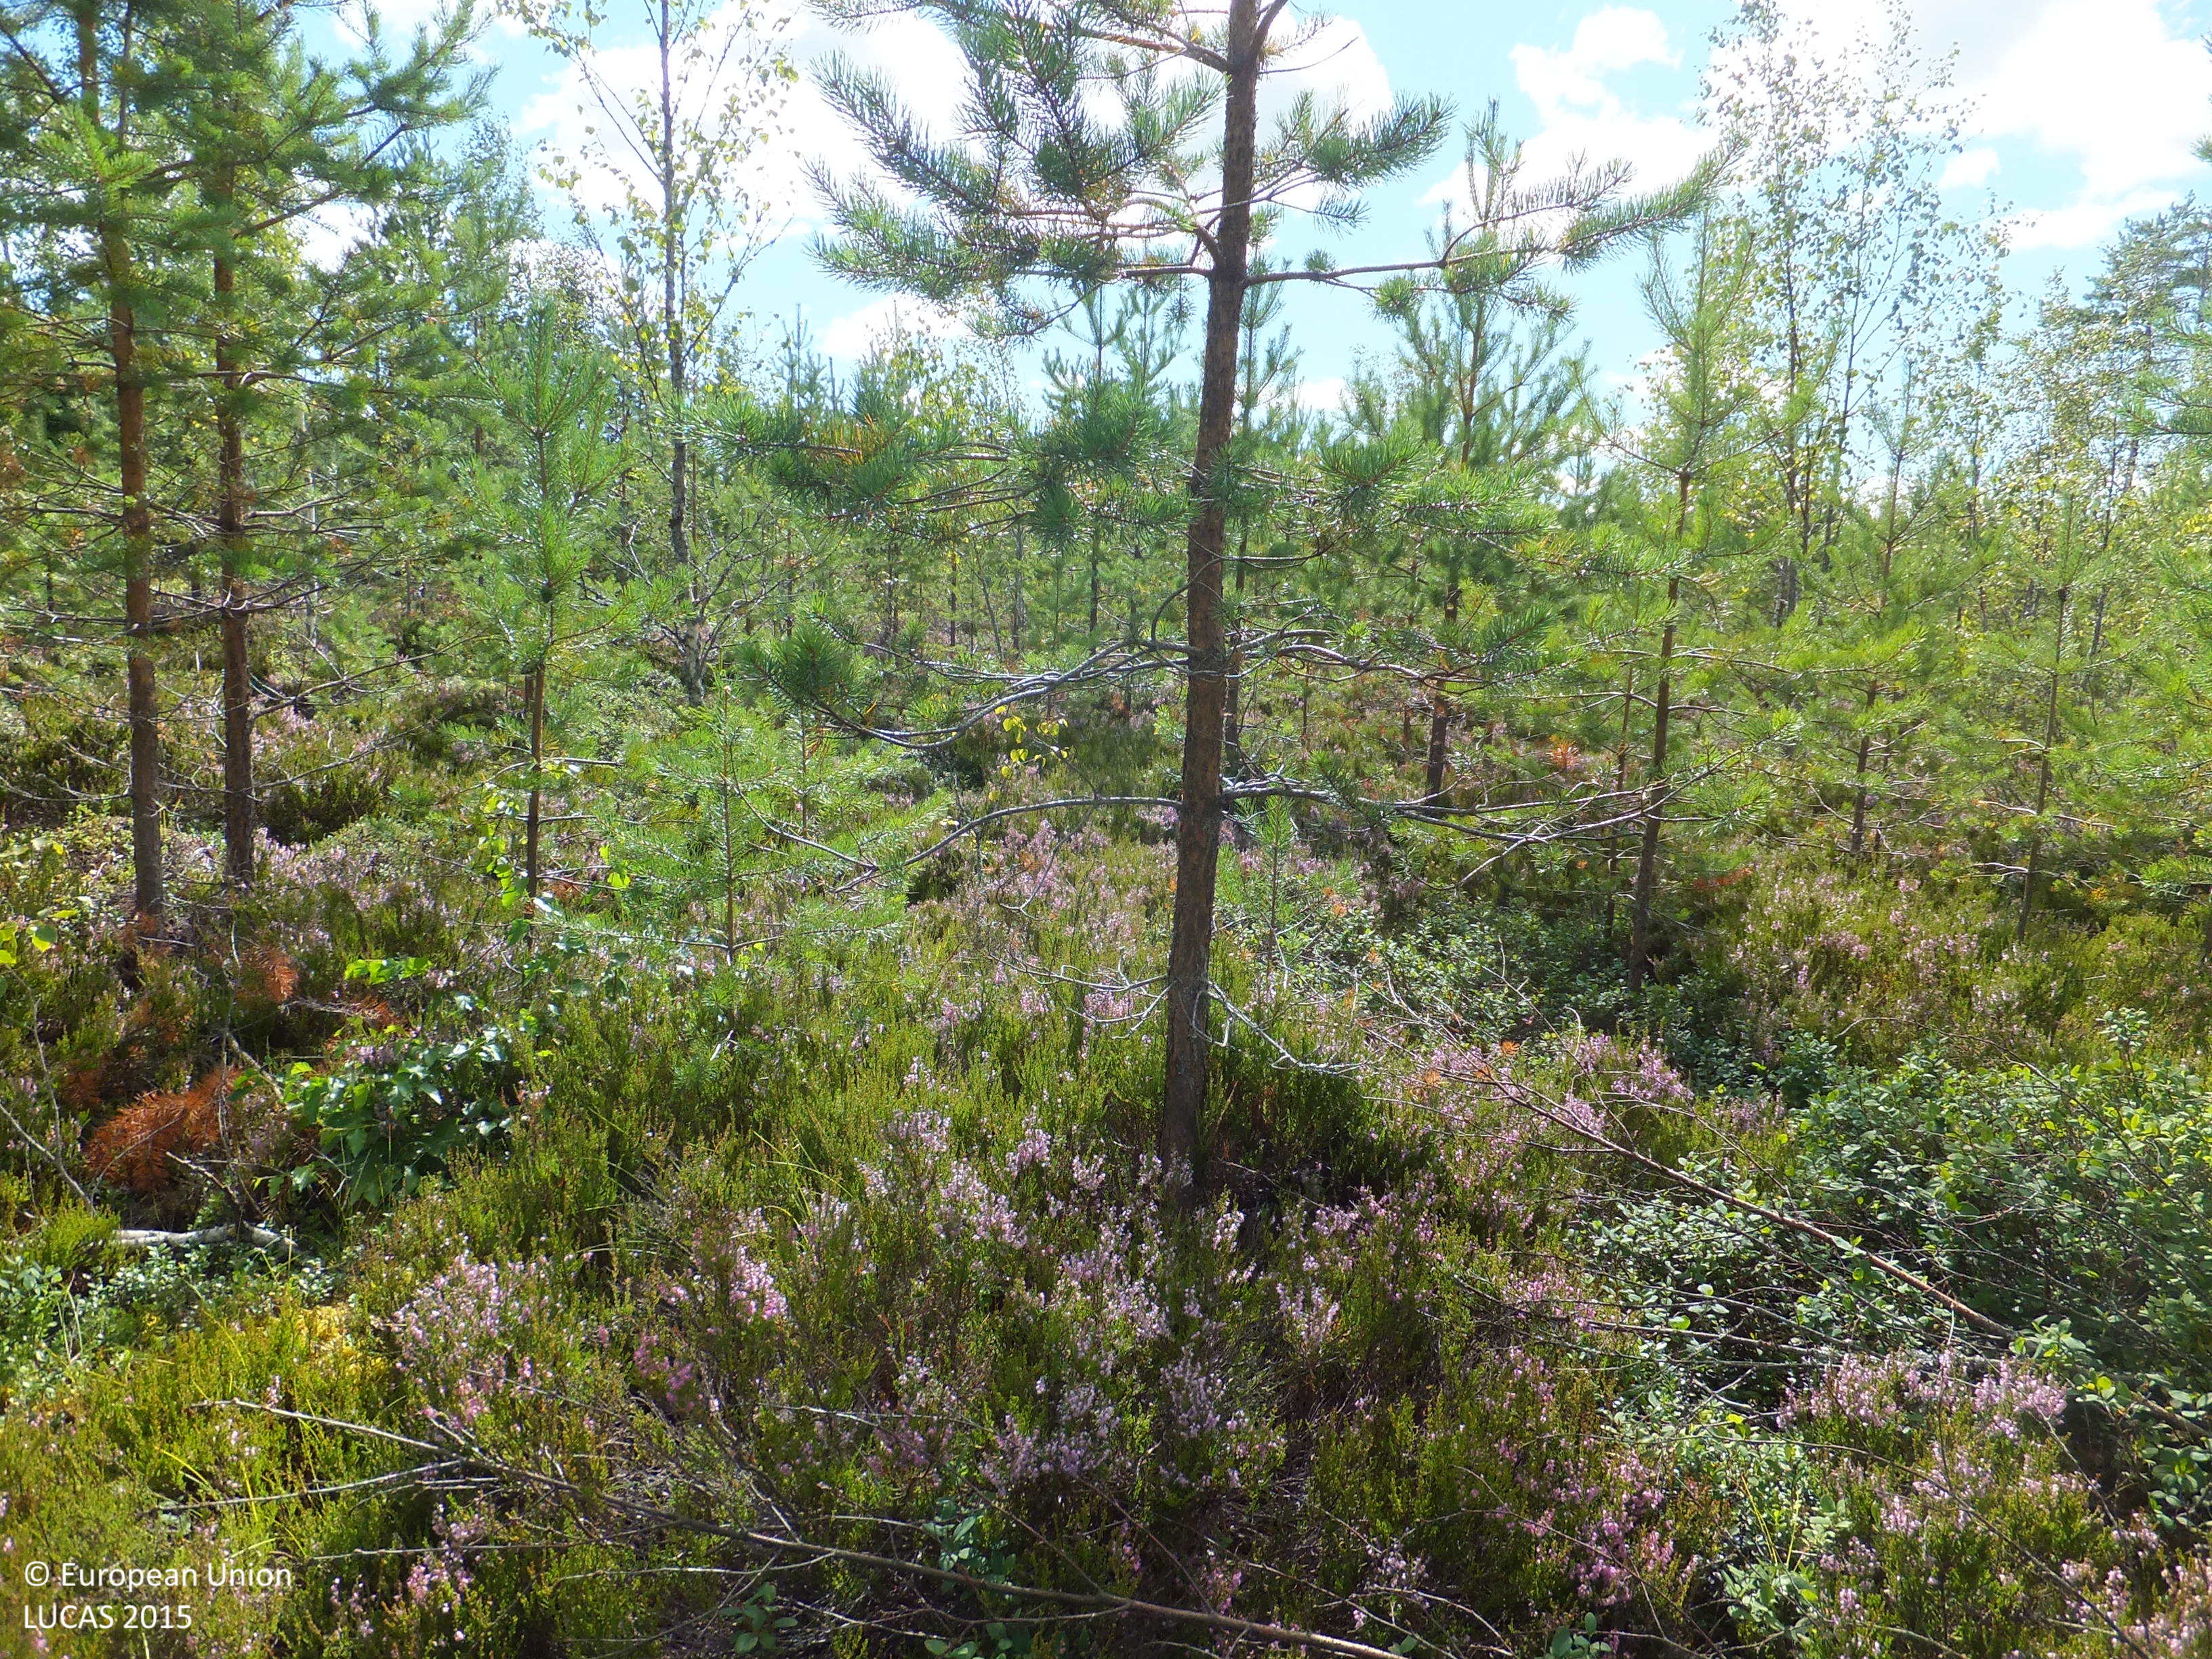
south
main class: Woodland
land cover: Pine dominated mixed woodland
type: boreal forest
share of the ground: 25 - 50 %
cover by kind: shrubs 30 %, coniferous forest trees 20 %, broadleaved forest trees 20 %, lichens and mosses 20 %, herbaceous plants 5 %, consolidated bare surface 5 %
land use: Forestry
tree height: < 5 m
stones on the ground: 10 - 25 %
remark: Nursery
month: August
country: FI
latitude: 63.2634
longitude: 22.9055
